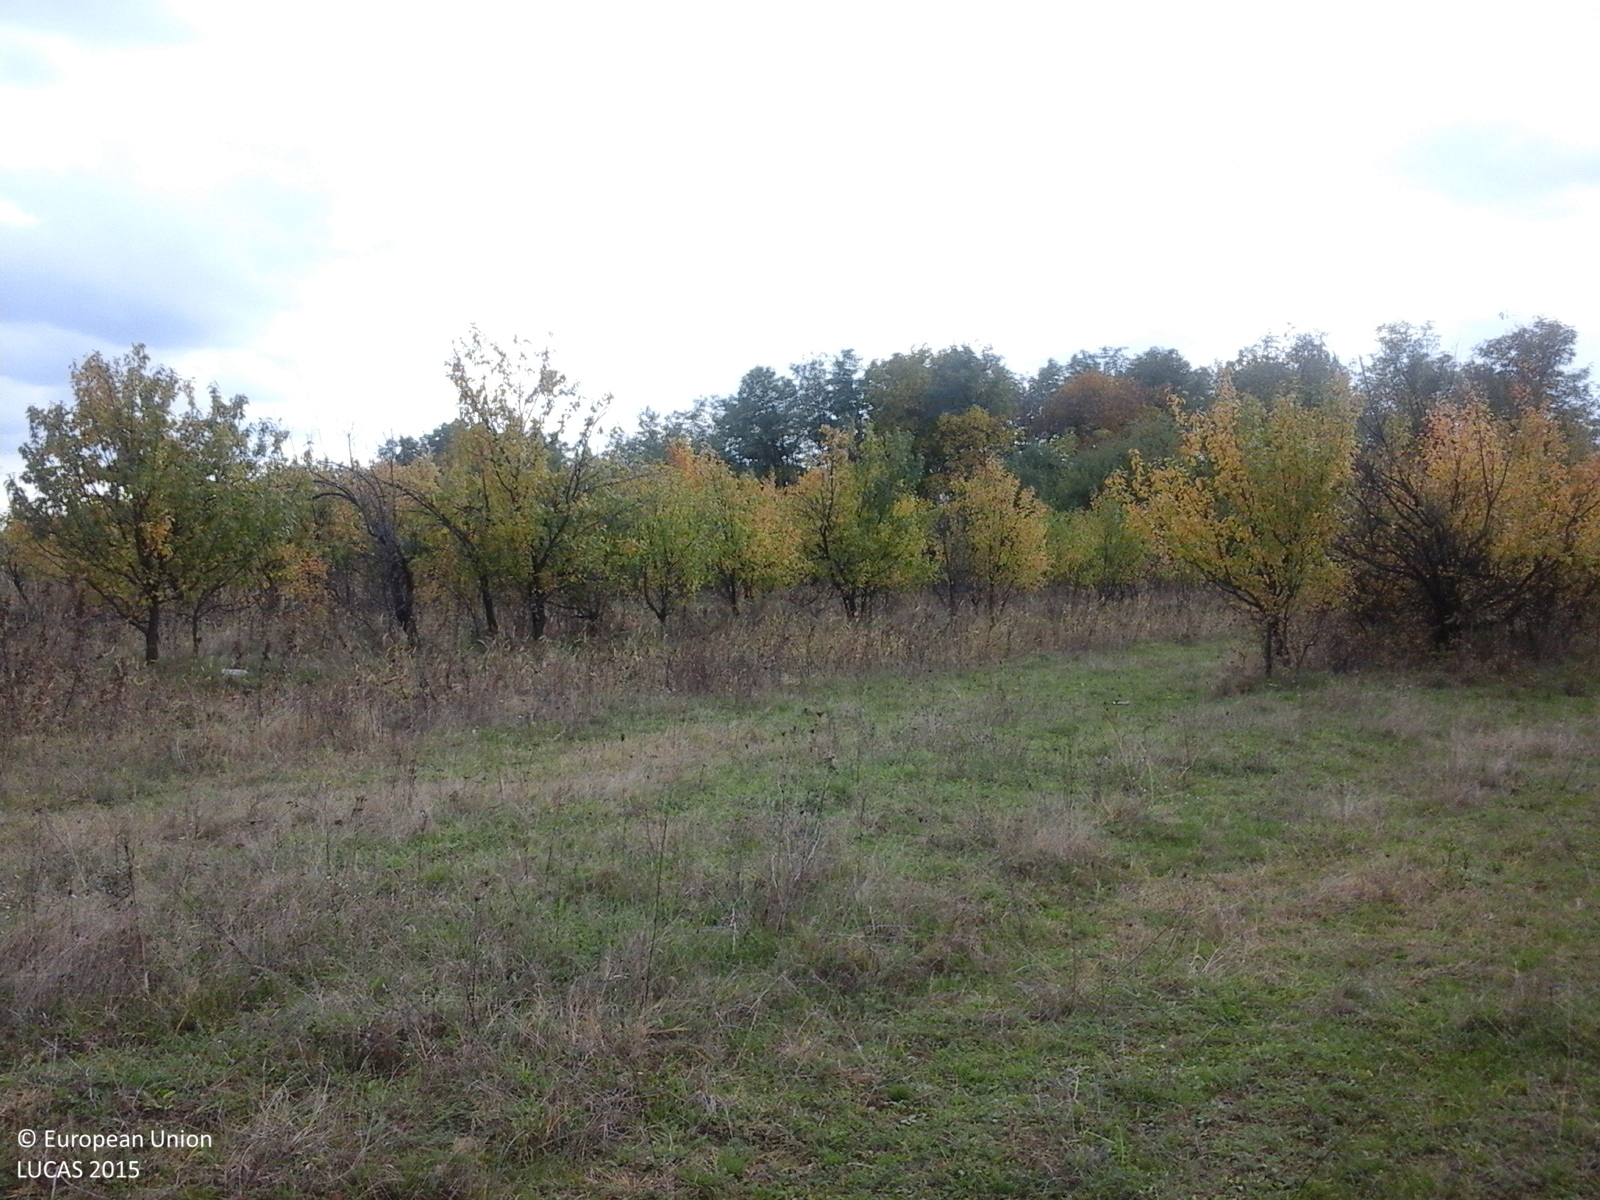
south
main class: Grassland
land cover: Grassland without tree/shrub cover
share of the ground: > 75 %
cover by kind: herbaceous plants 100 %
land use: Agriculture (excluding fallow land and kitchen gardens)
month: October
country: RO
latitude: 45.0946
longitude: 25.7971
